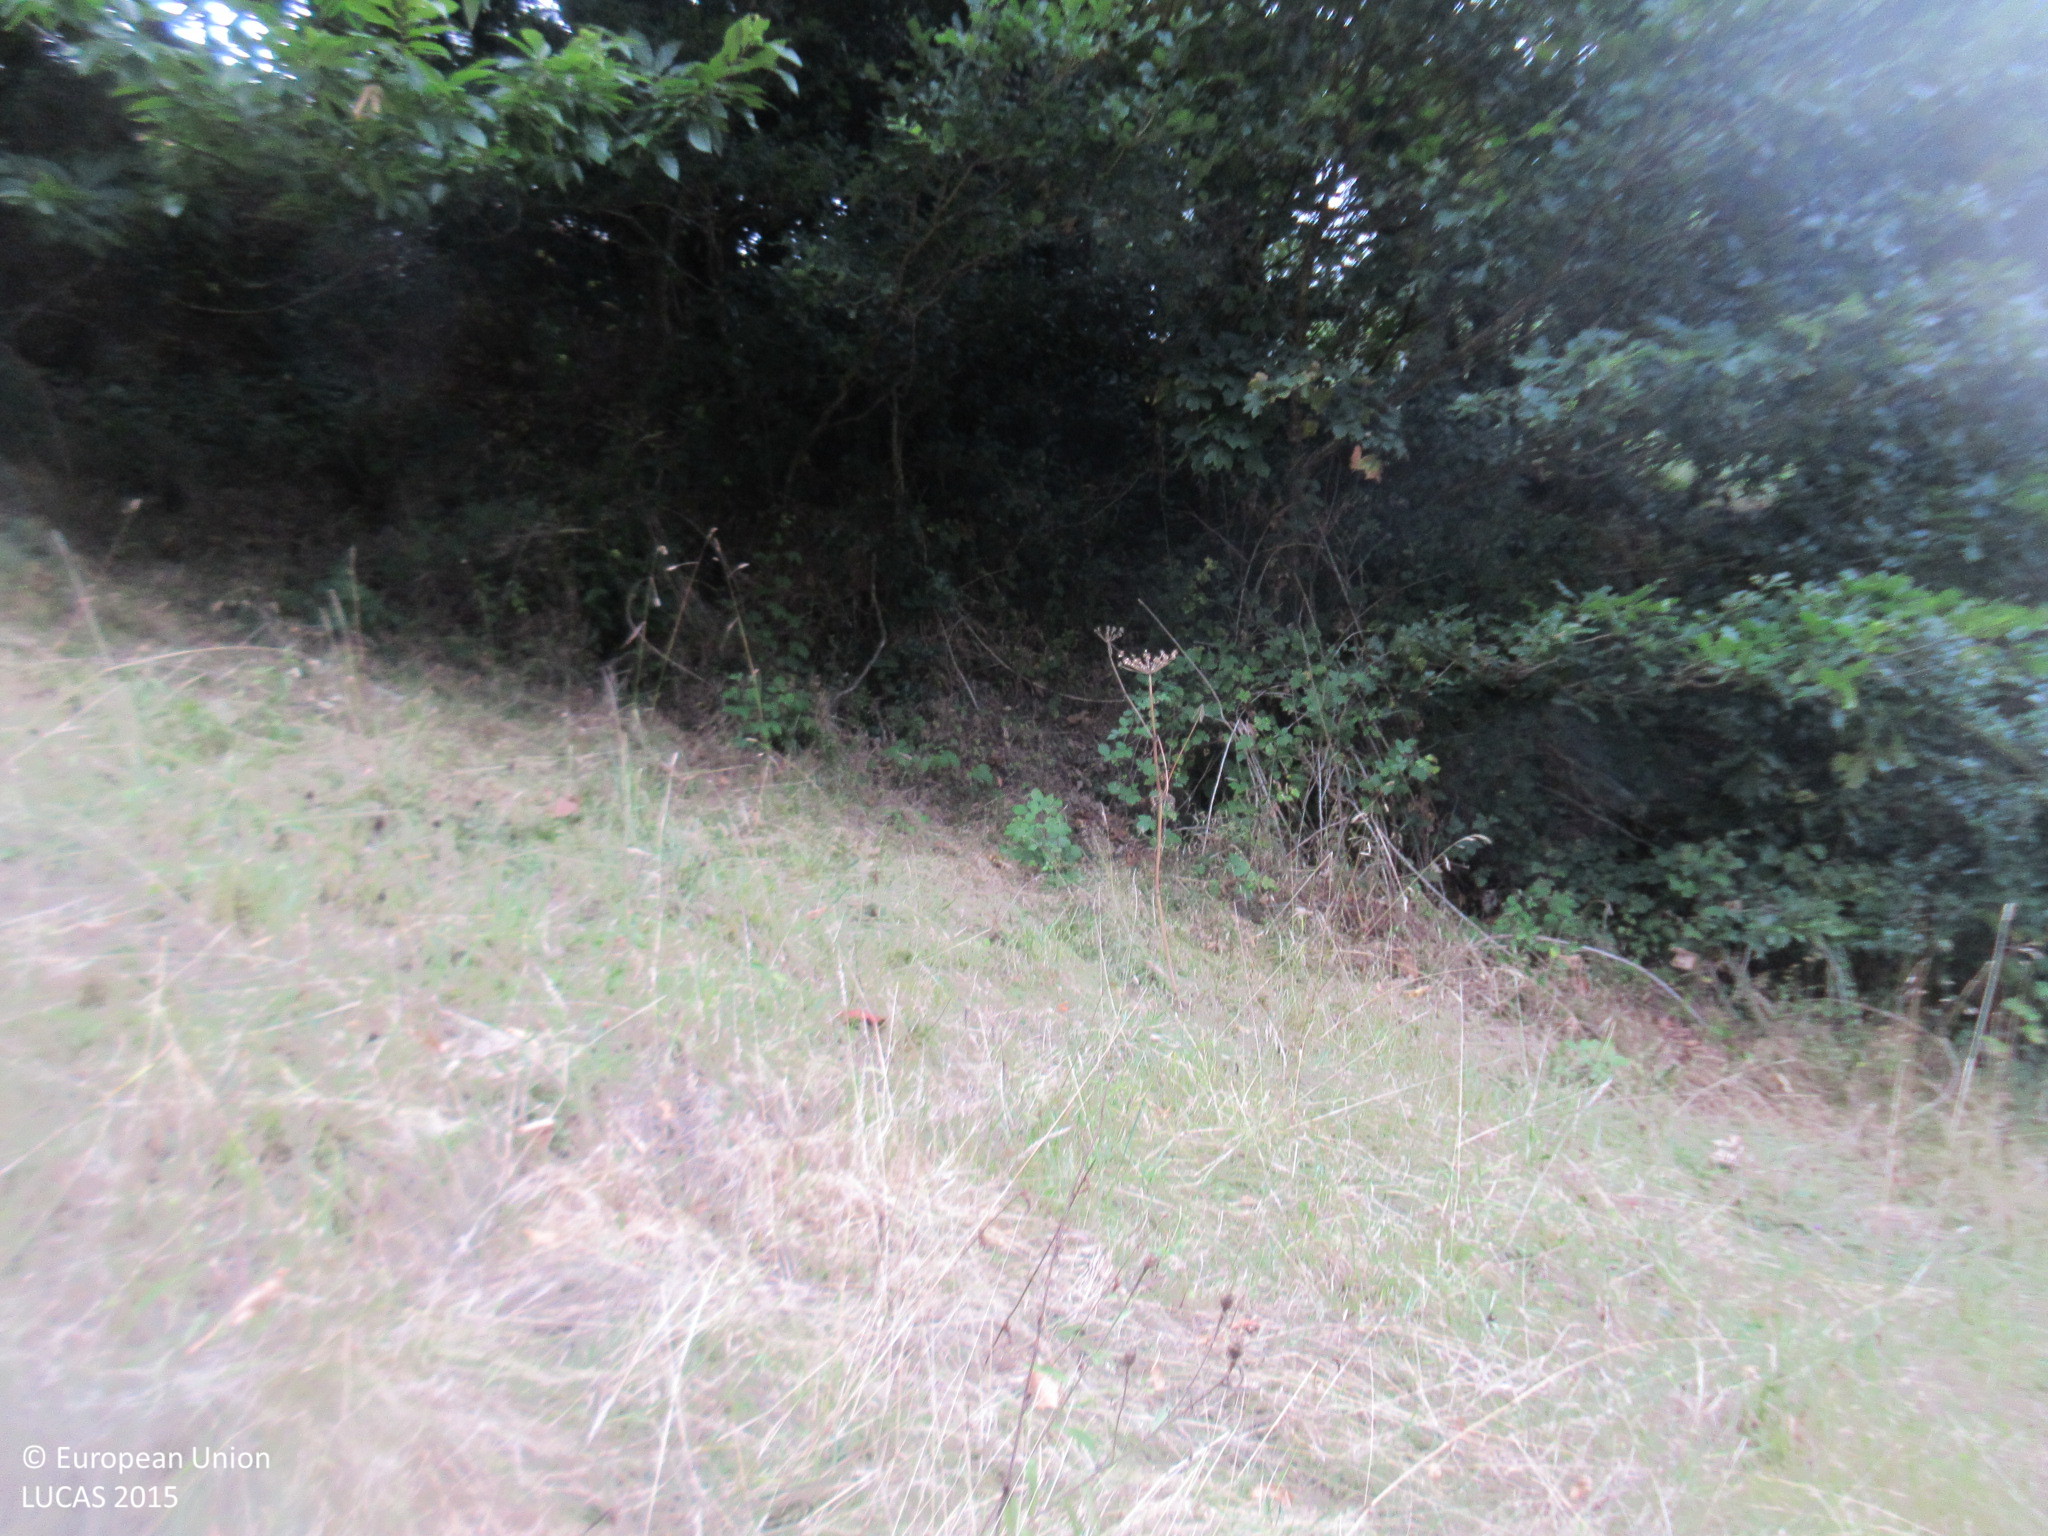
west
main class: Grassland
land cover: Grassland without tree/shrub cover
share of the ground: > 75 %
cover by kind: herbaceous plants 100 %
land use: Agriculture (excluding fallow land and kitchen gardens)
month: August
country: ES
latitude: 43.3610
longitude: -6.6537
